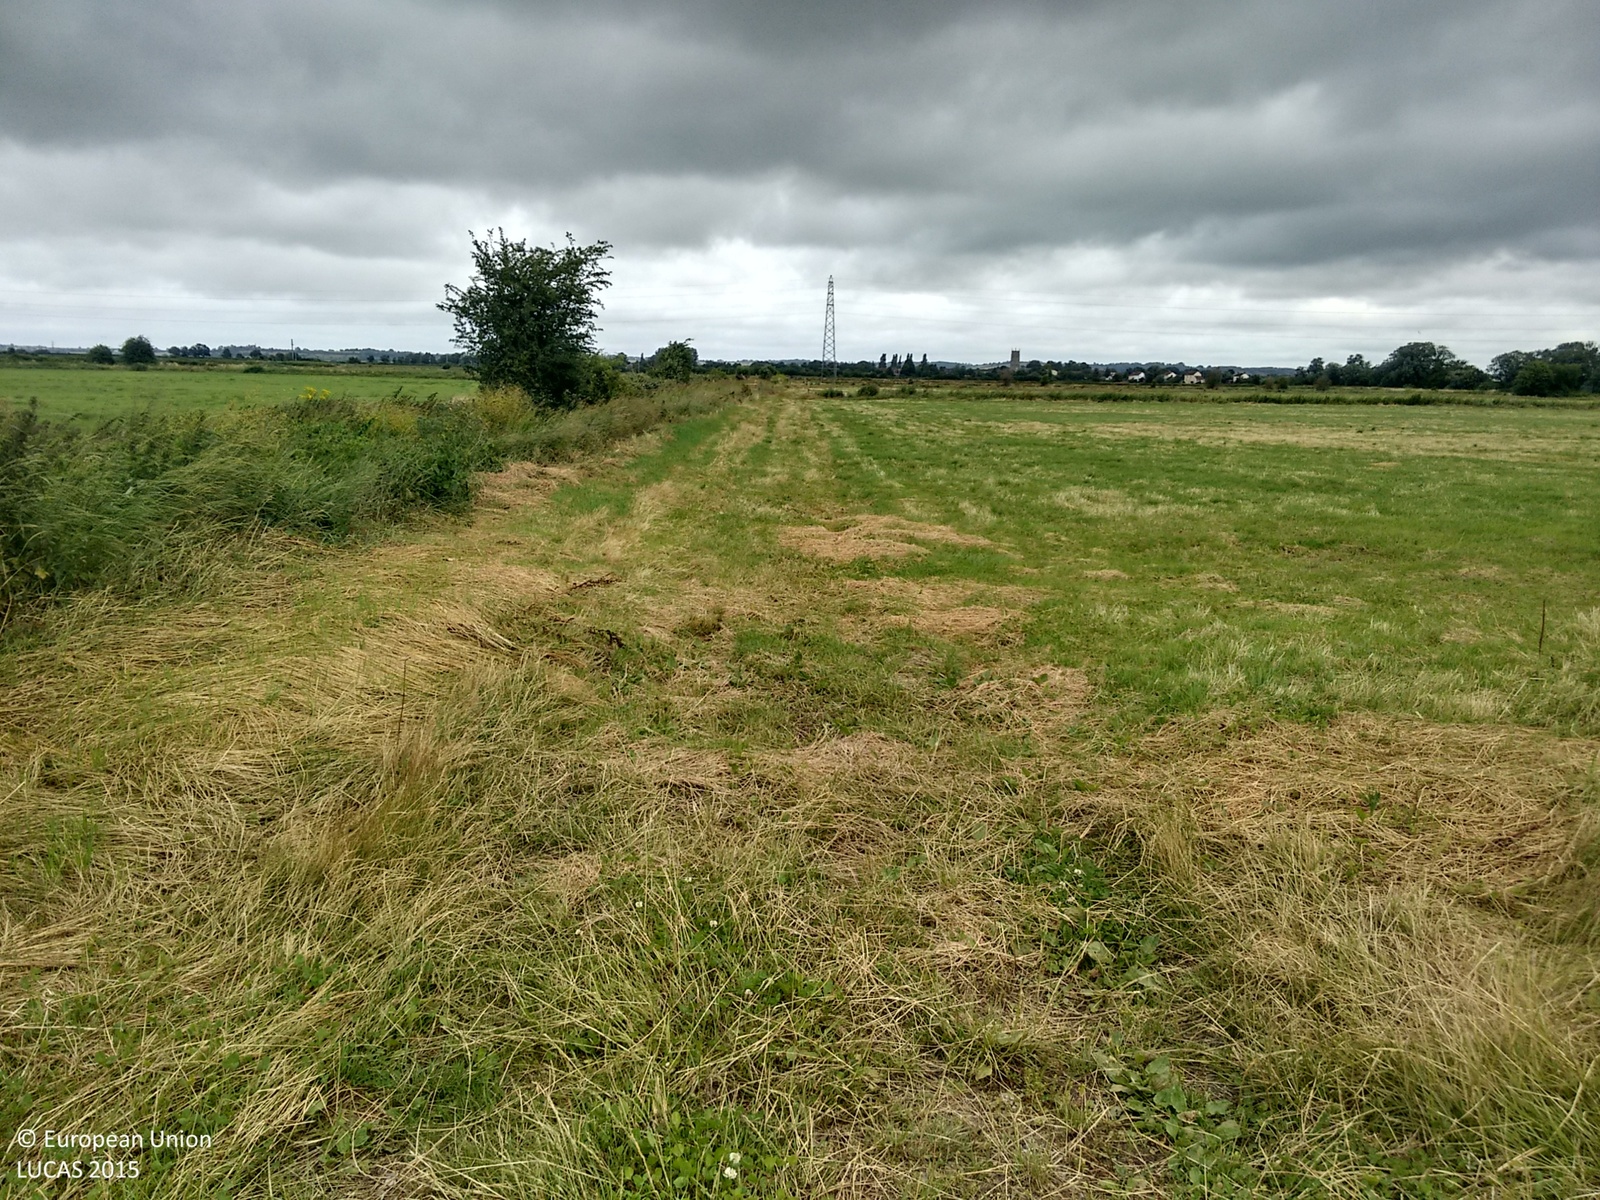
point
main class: Cropland
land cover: Temporary grasslands
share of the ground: > 75 %
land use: Agriculture (excluding fallow land and kitchen gardens)
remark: Harvested field
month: July
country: GB
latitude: 51.1006
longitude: -2.9408
